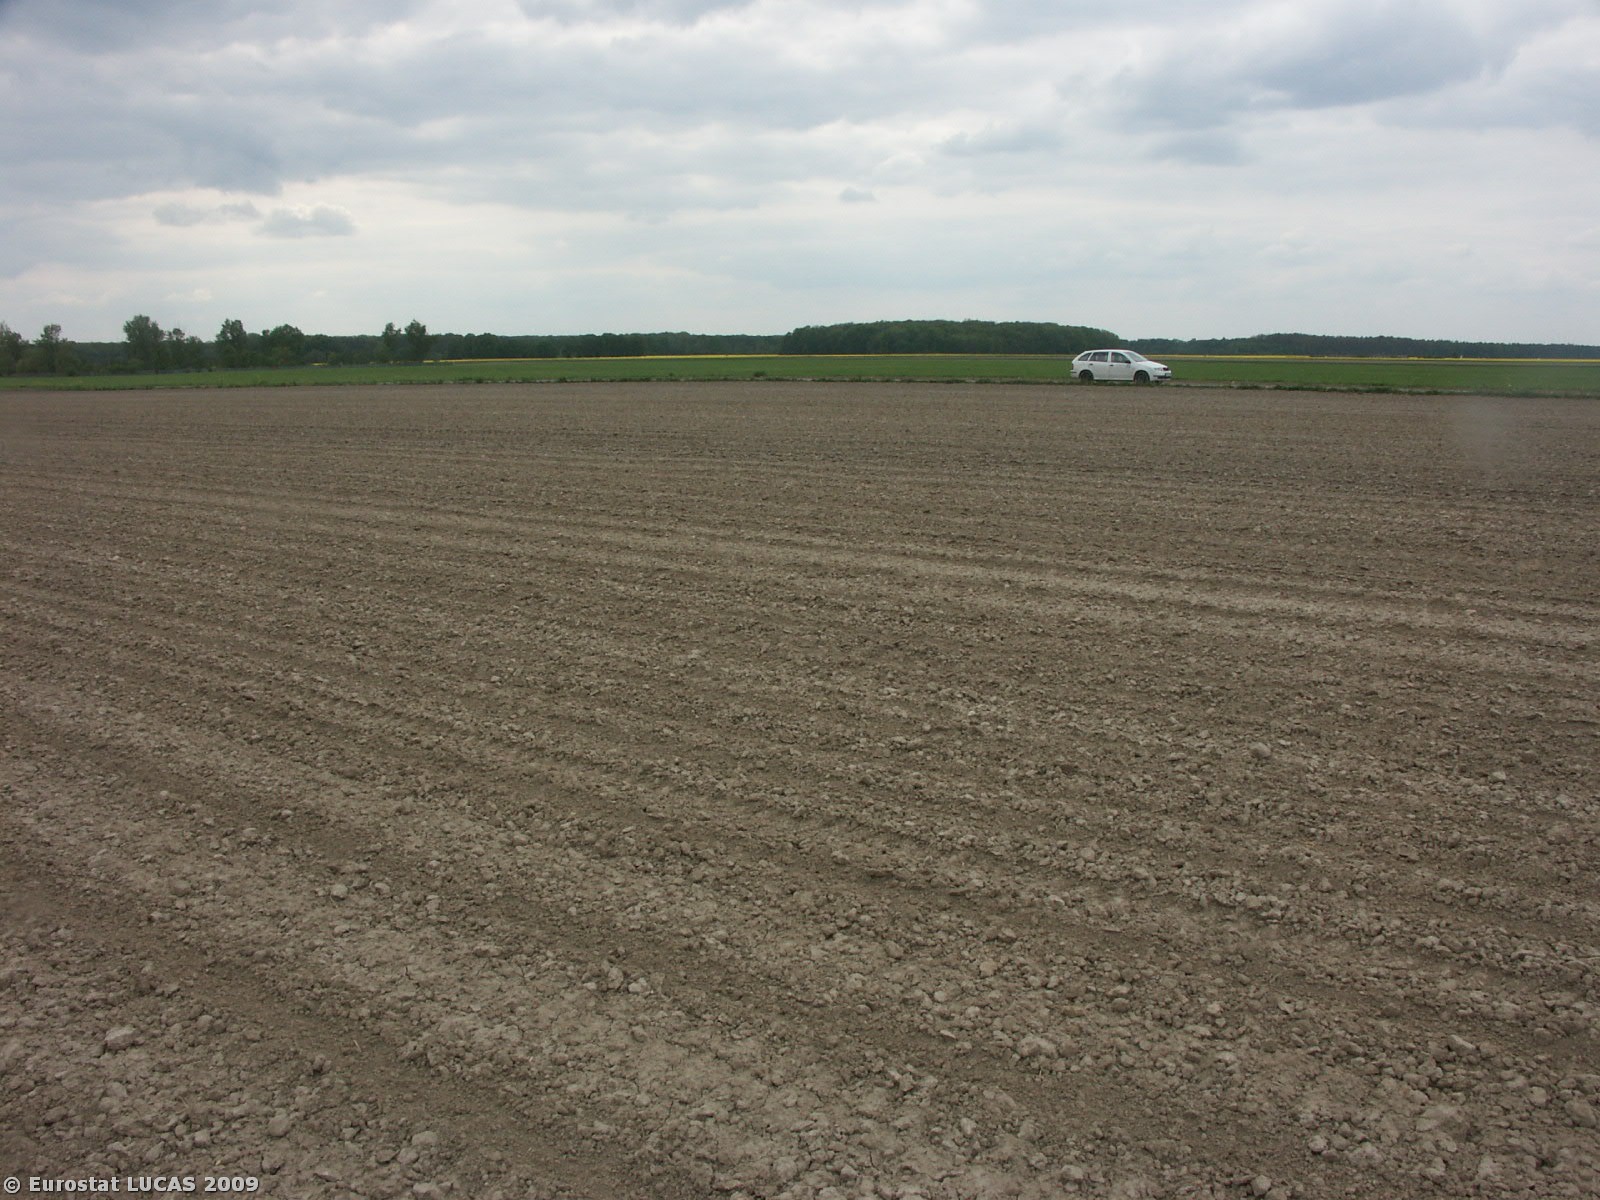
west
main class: Cropland
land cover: Maize
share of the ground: < 10 %
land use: Agriculture (excluding fallow land and kitchen gardens)
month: May
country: CZ
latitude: 49.6854
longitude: 17.2042
